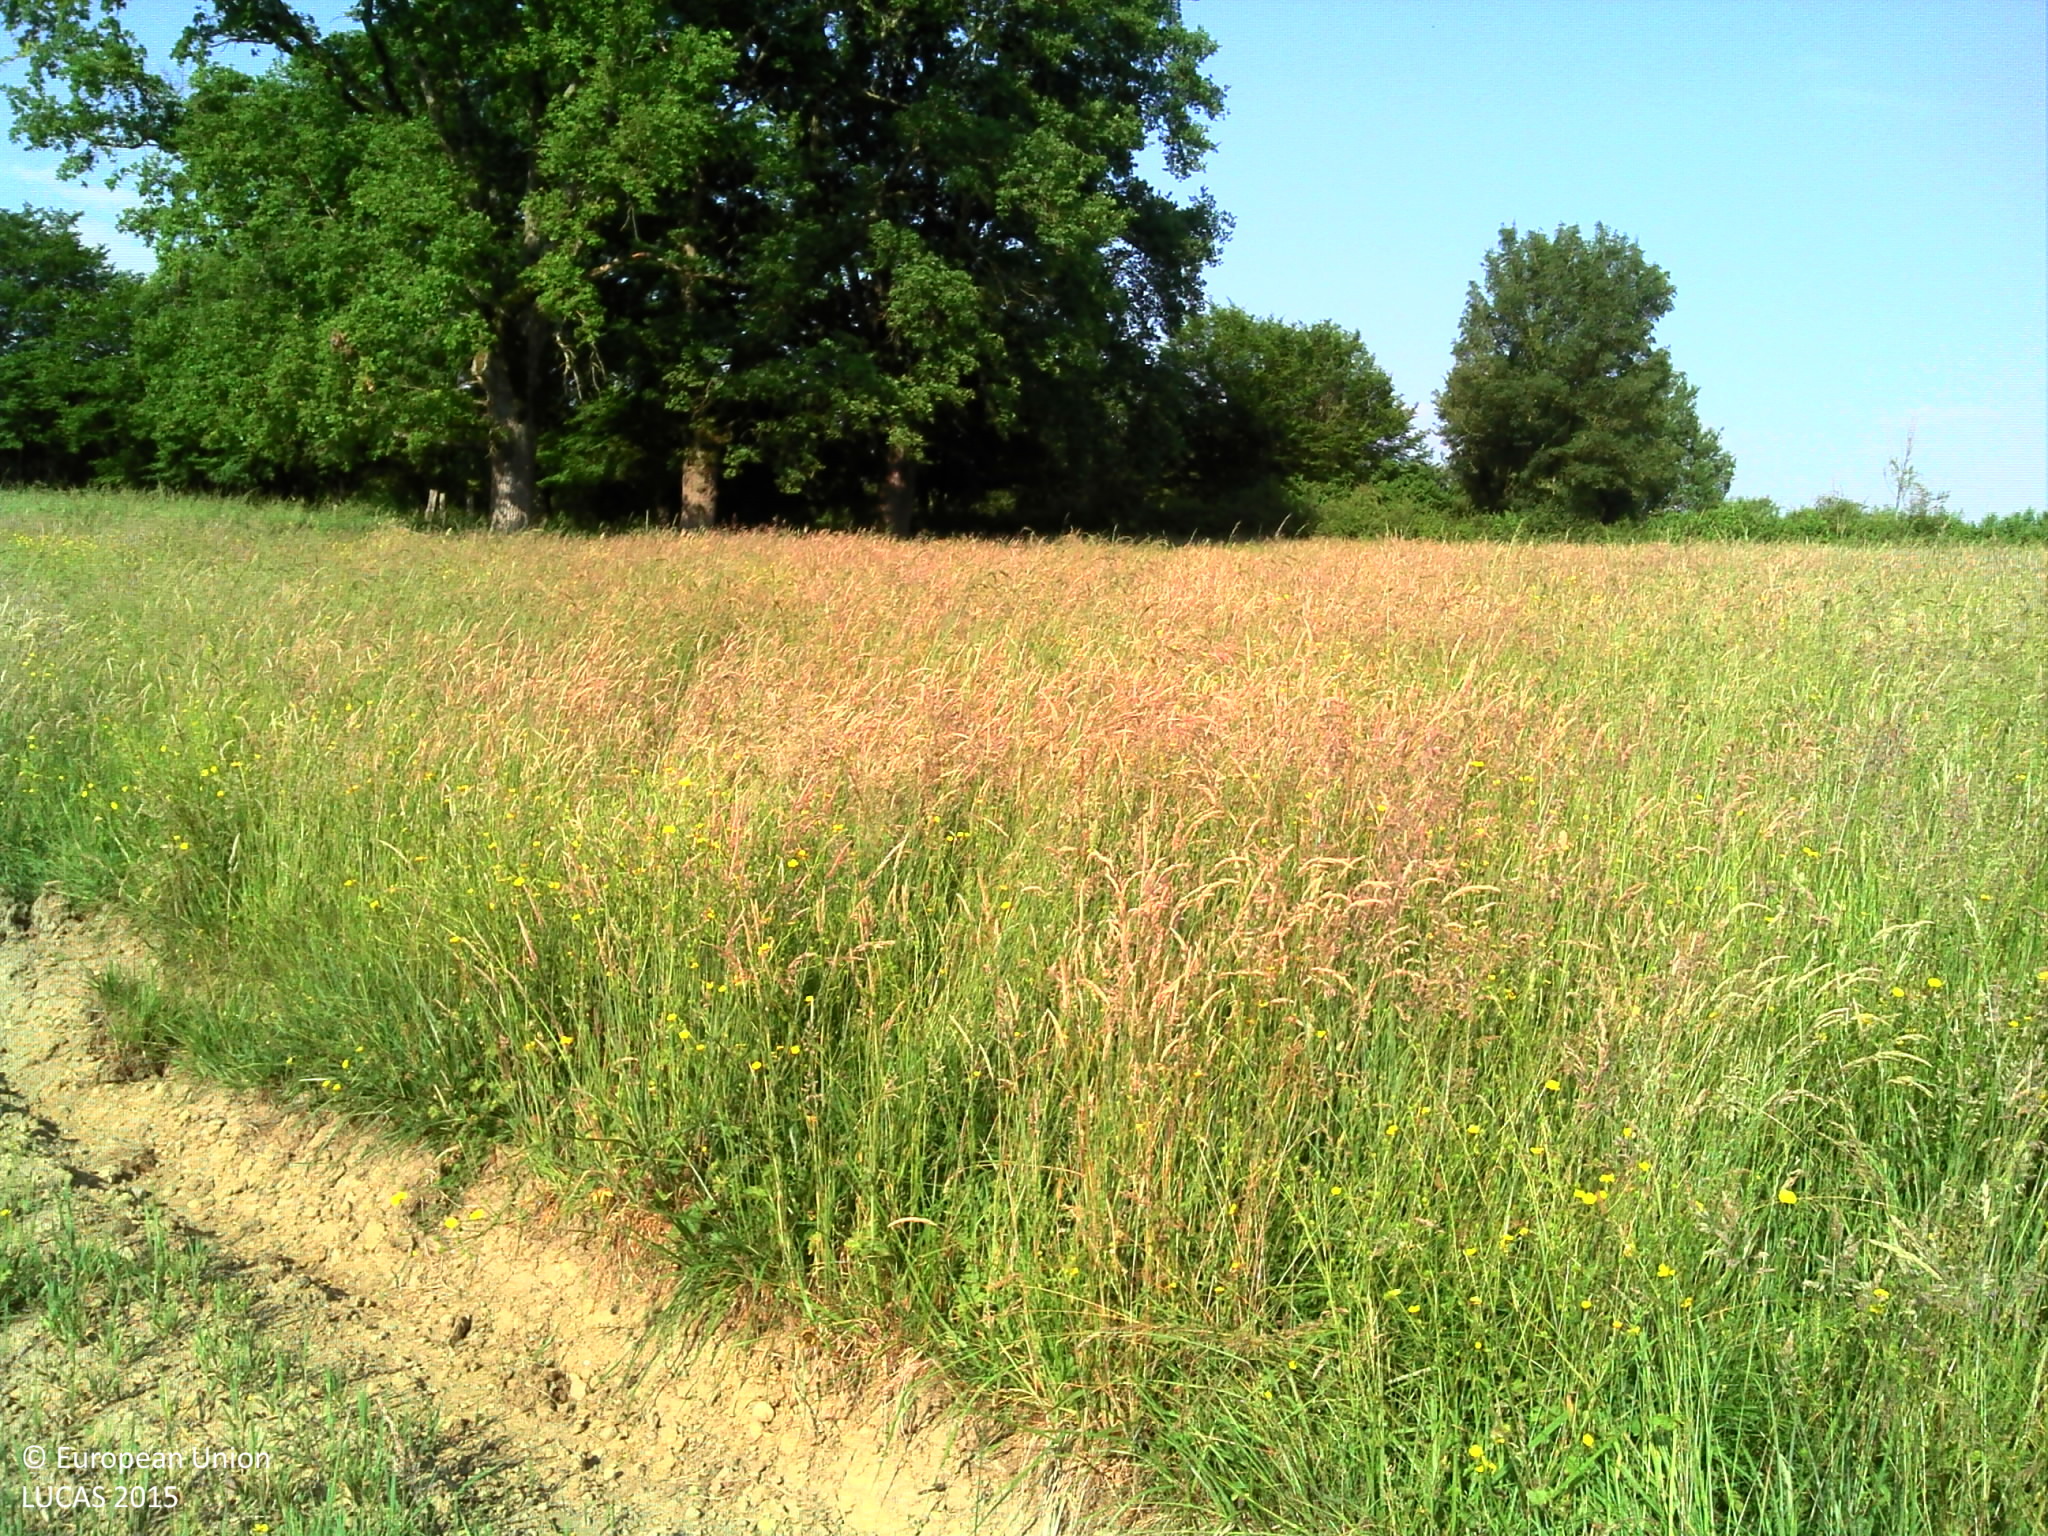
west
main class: Cropland
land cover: Barley
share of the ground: > 75 %
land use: Agriculture (excluding fallow land and kitchen gardens)
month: June
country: FR
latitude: 46.7527
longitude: 2.7035
